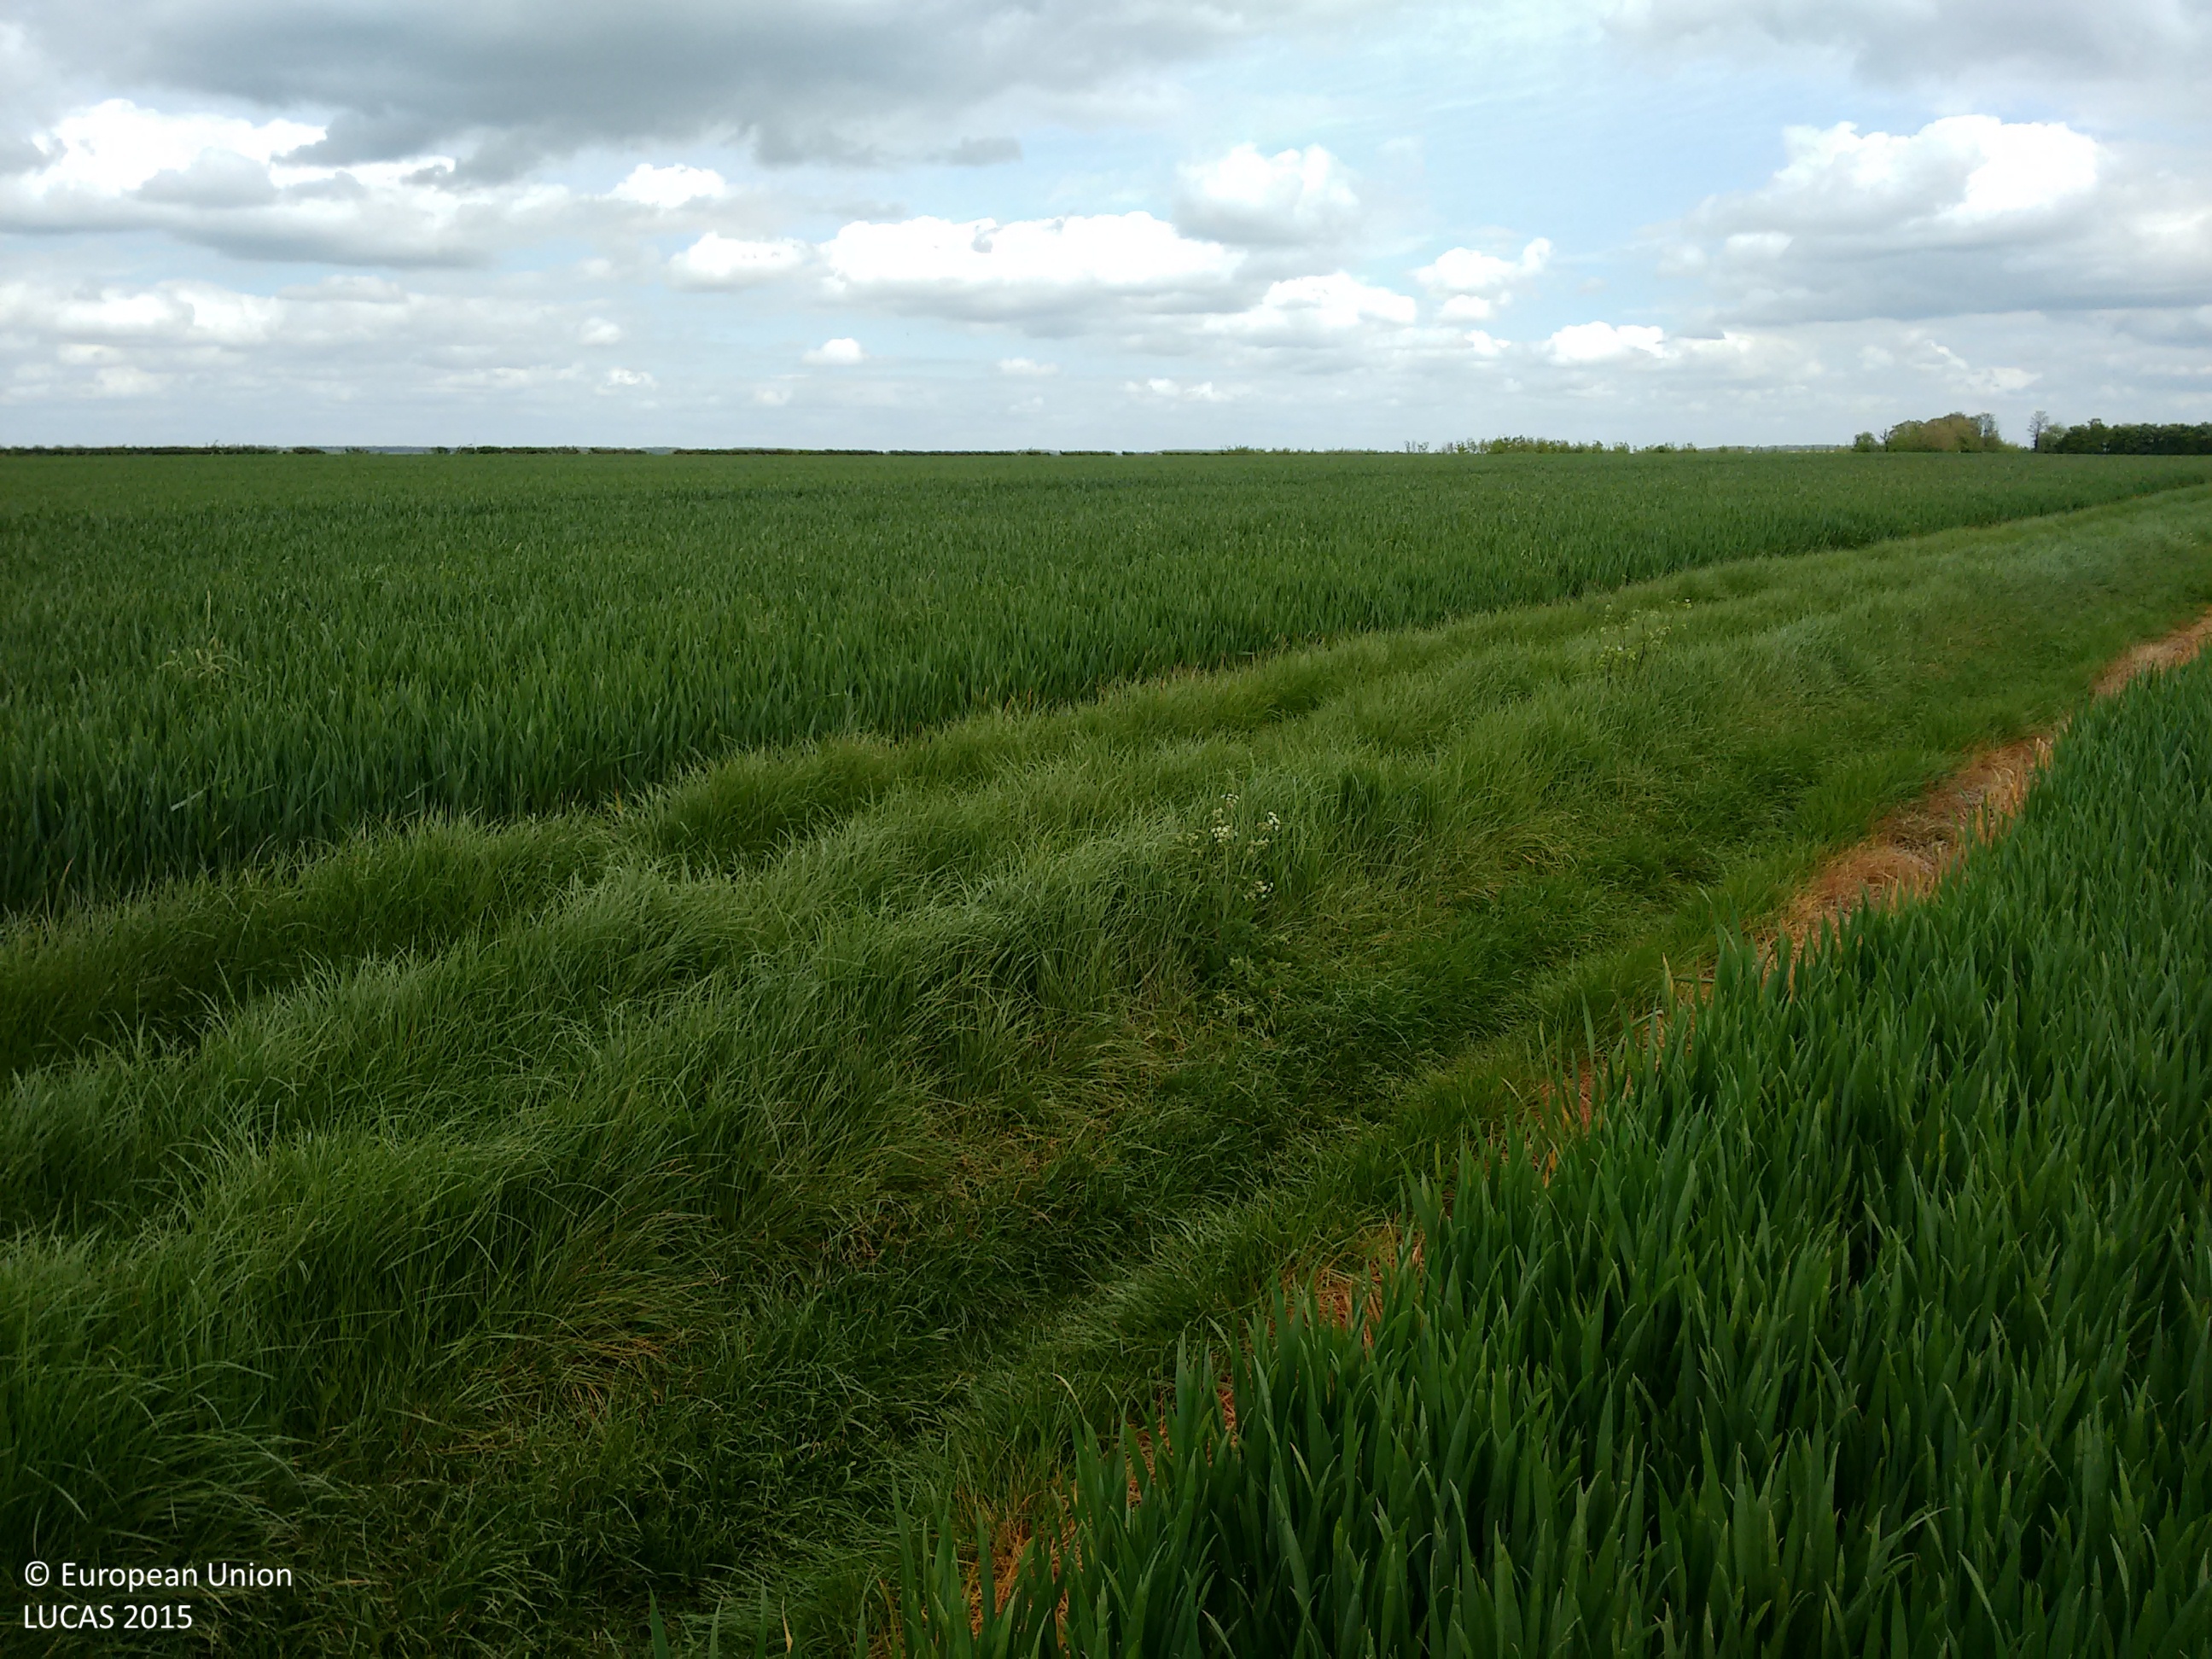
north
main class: Cropland
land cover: Common wheat
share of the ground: > 75 %
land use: Agriculture (excluding fallow land and kitchen gardens)
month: May
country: GB
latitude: 52.1955
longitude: -0.5577
